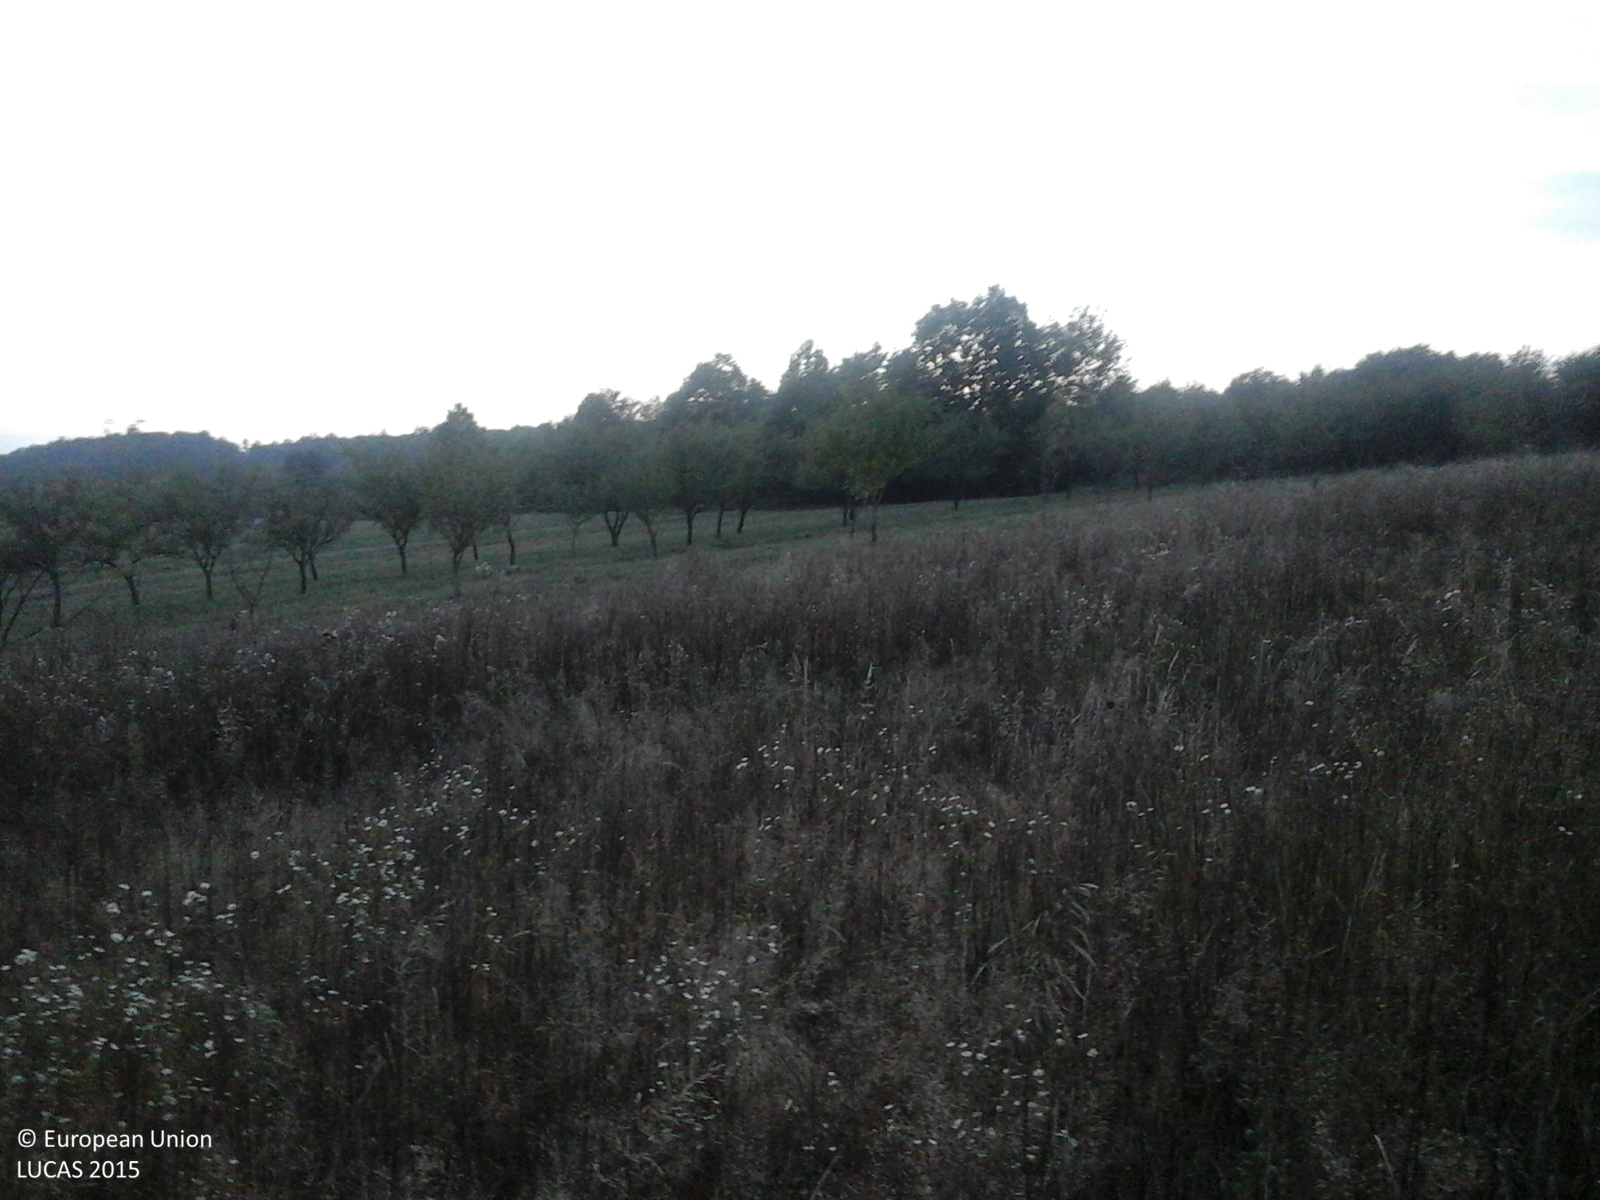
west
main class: Grassland
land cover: Spontaneously vegetated surfaces
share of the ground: > 75 %
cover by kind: herbaceous plants 100 %
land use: Agriculture (excluding fallow land and kitchen gardens)
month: September
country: RO
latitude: 47.1305
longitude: 22.6205
